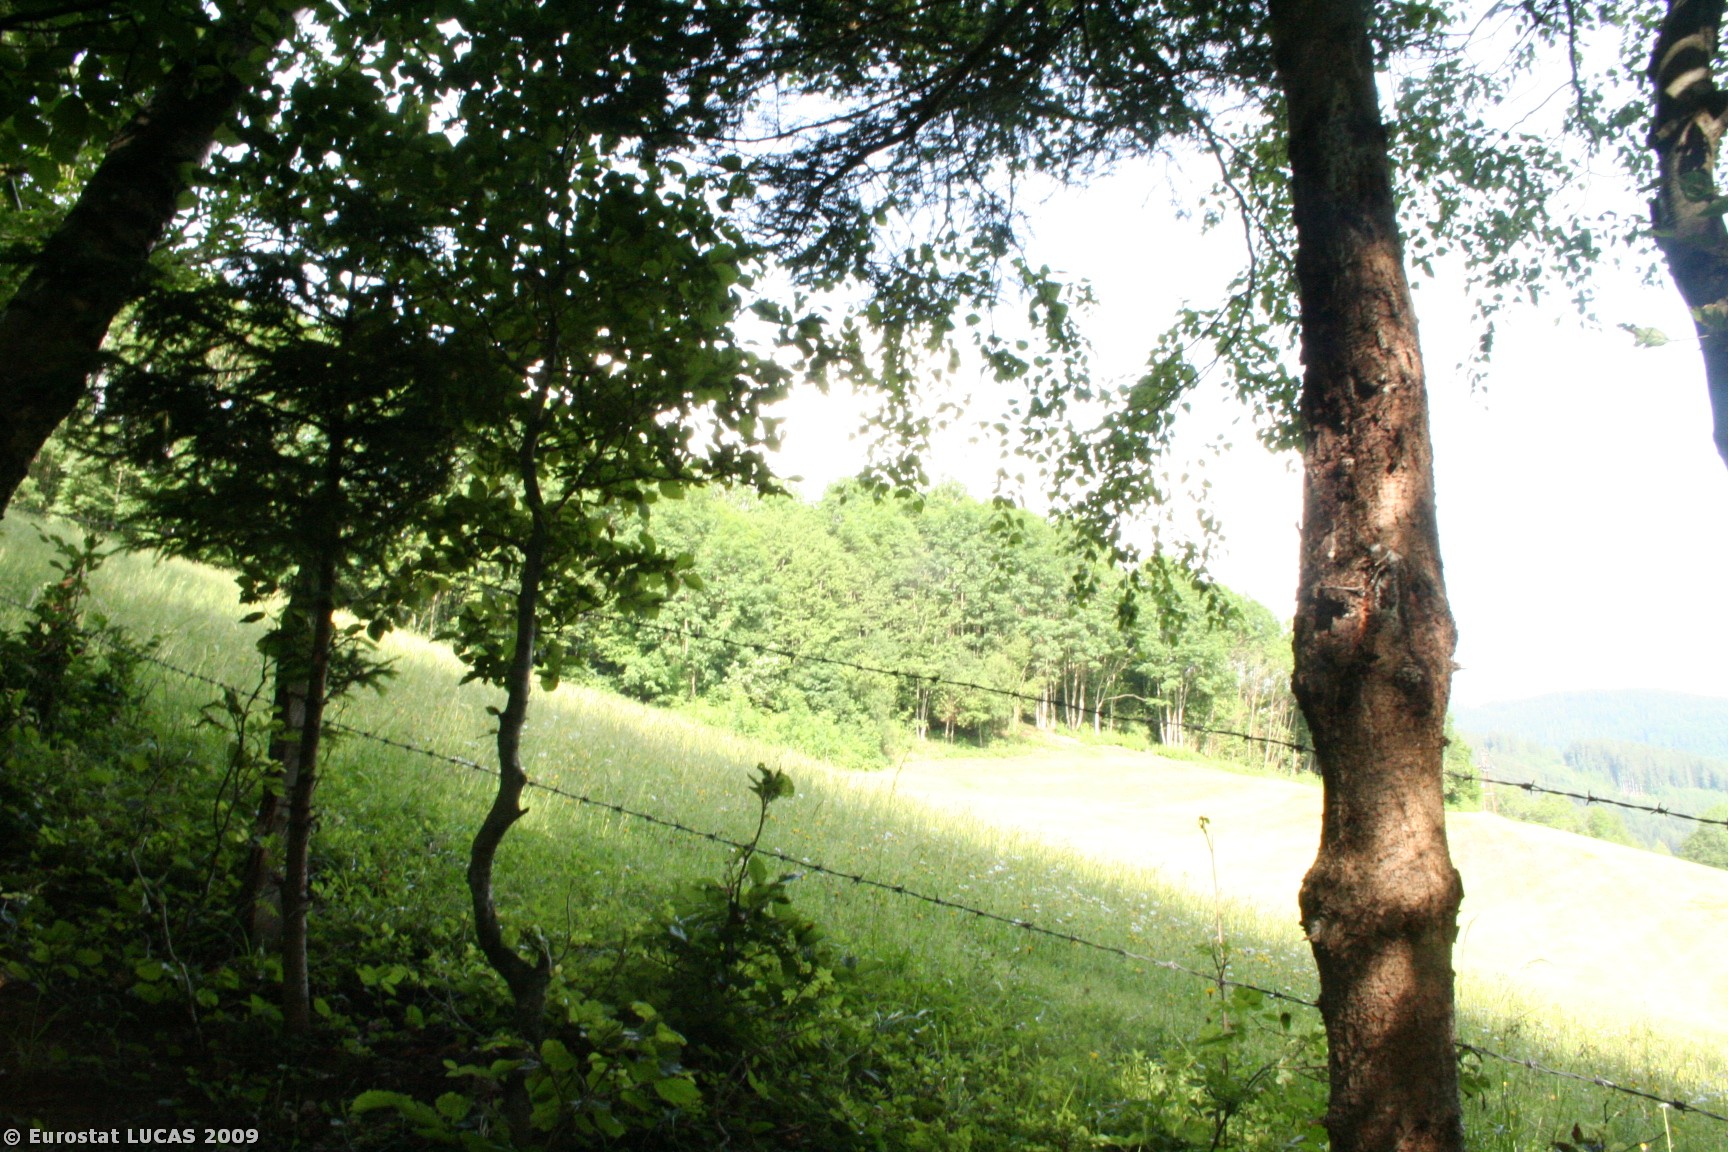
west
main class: Woodland
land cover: Broadleaved woodland
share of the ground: 50 - 75 %
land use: Forestry
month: June
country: AT
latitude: 47.4568
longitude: 13.1950
